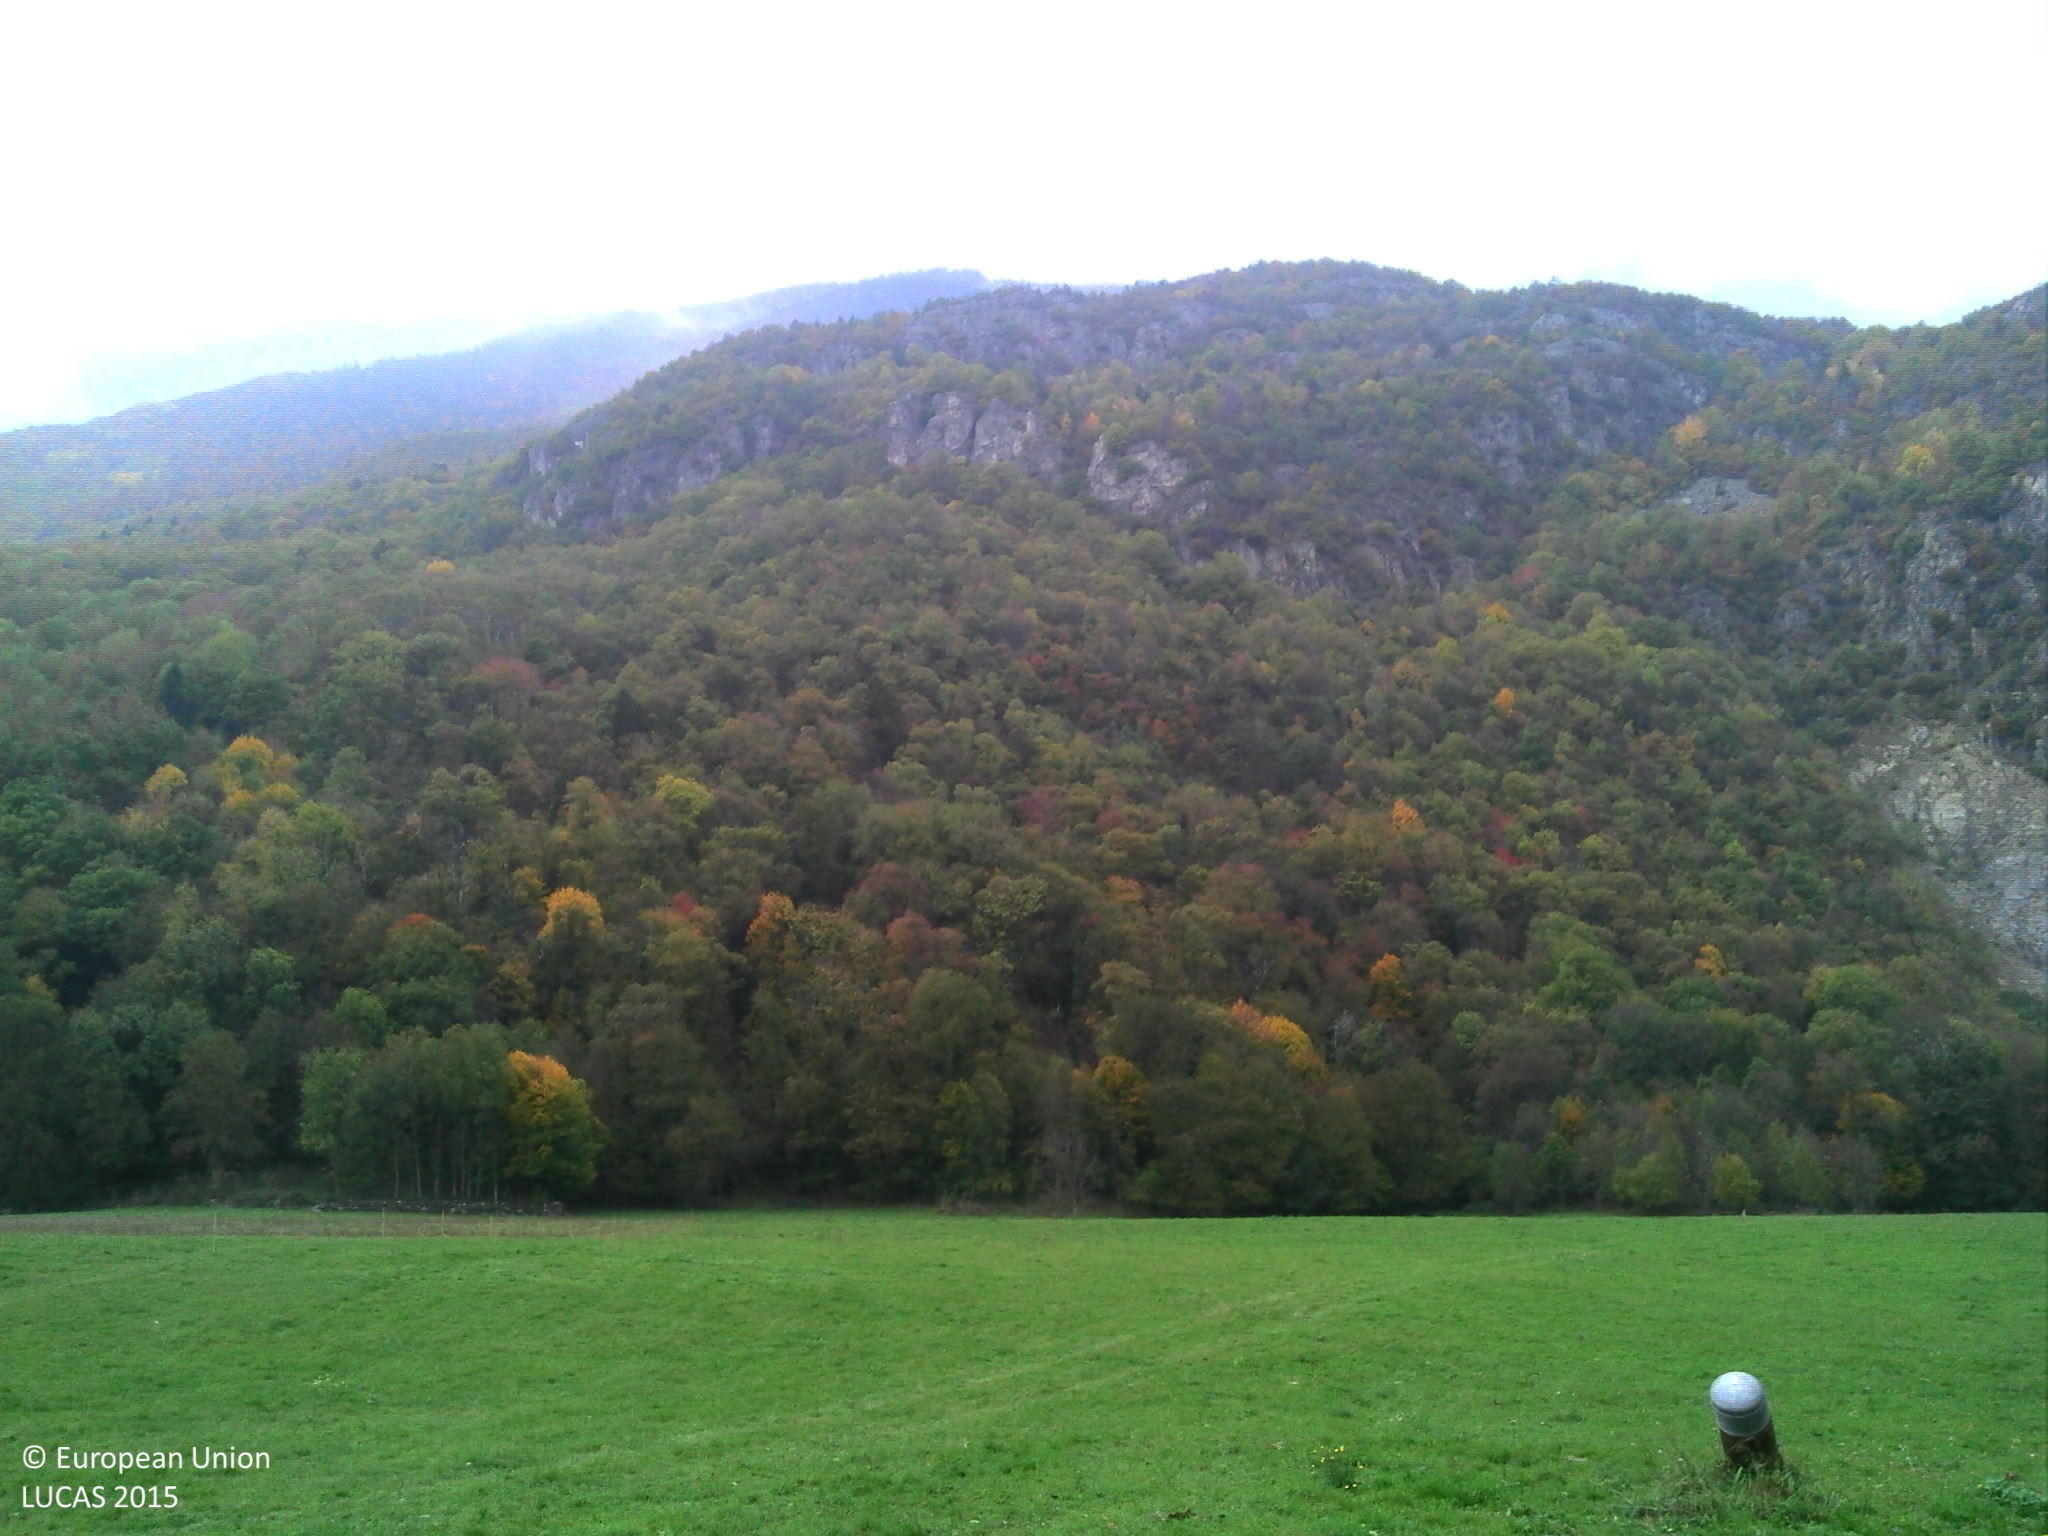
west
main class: Grassland
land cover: Grassland with sparse tree/shrub cover
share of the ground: > 75 %
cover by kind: herbaceous plants 90 %, broadleaved forest trees 5 %, consolidated bare surface 5 %
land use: Agriculture (excluding fallow land and kitchen gardens)
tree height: > 5 m
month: October
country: FR
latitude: 45.3491
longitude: 6.2907
